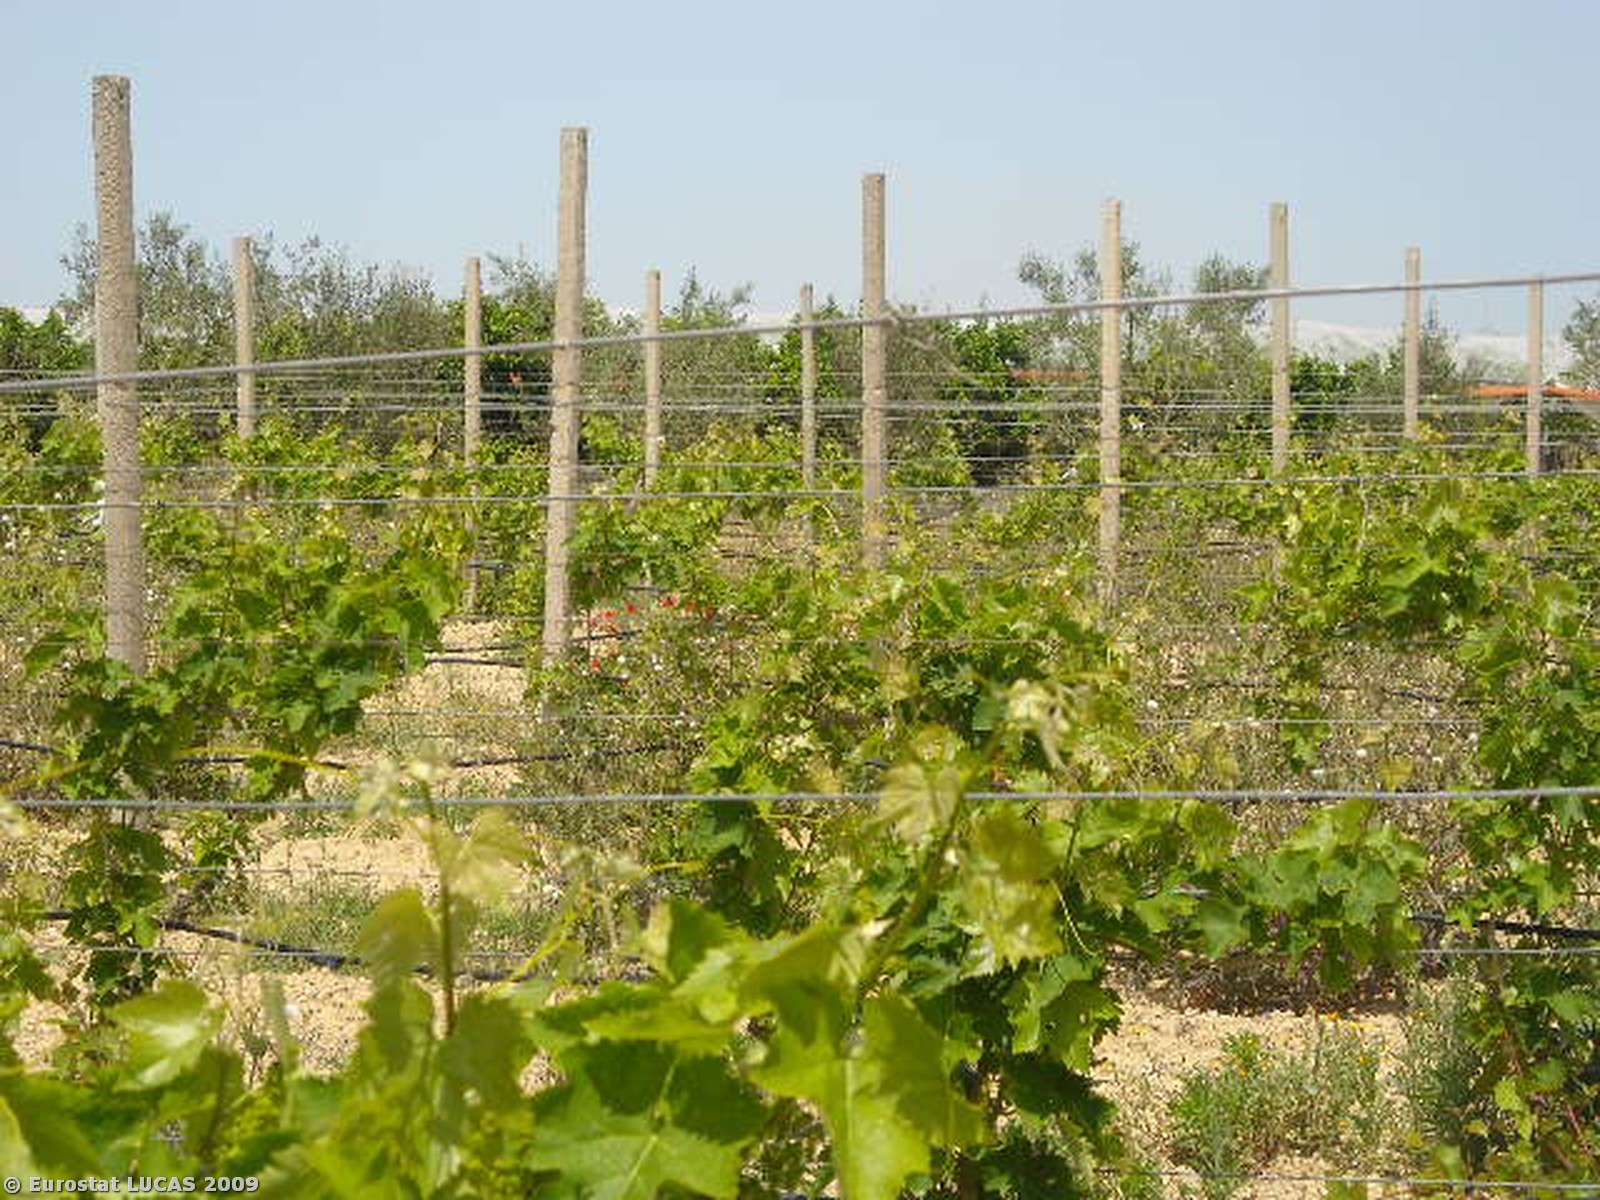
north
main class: Cropland
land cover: Vineyards
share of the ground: 25 - 50 %
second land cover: Bare land
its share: > 75 %
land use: Agriculture (excluding fallow land and kitchen gardens)
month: May
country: IT
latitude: 40.5305
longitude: 16.9291
